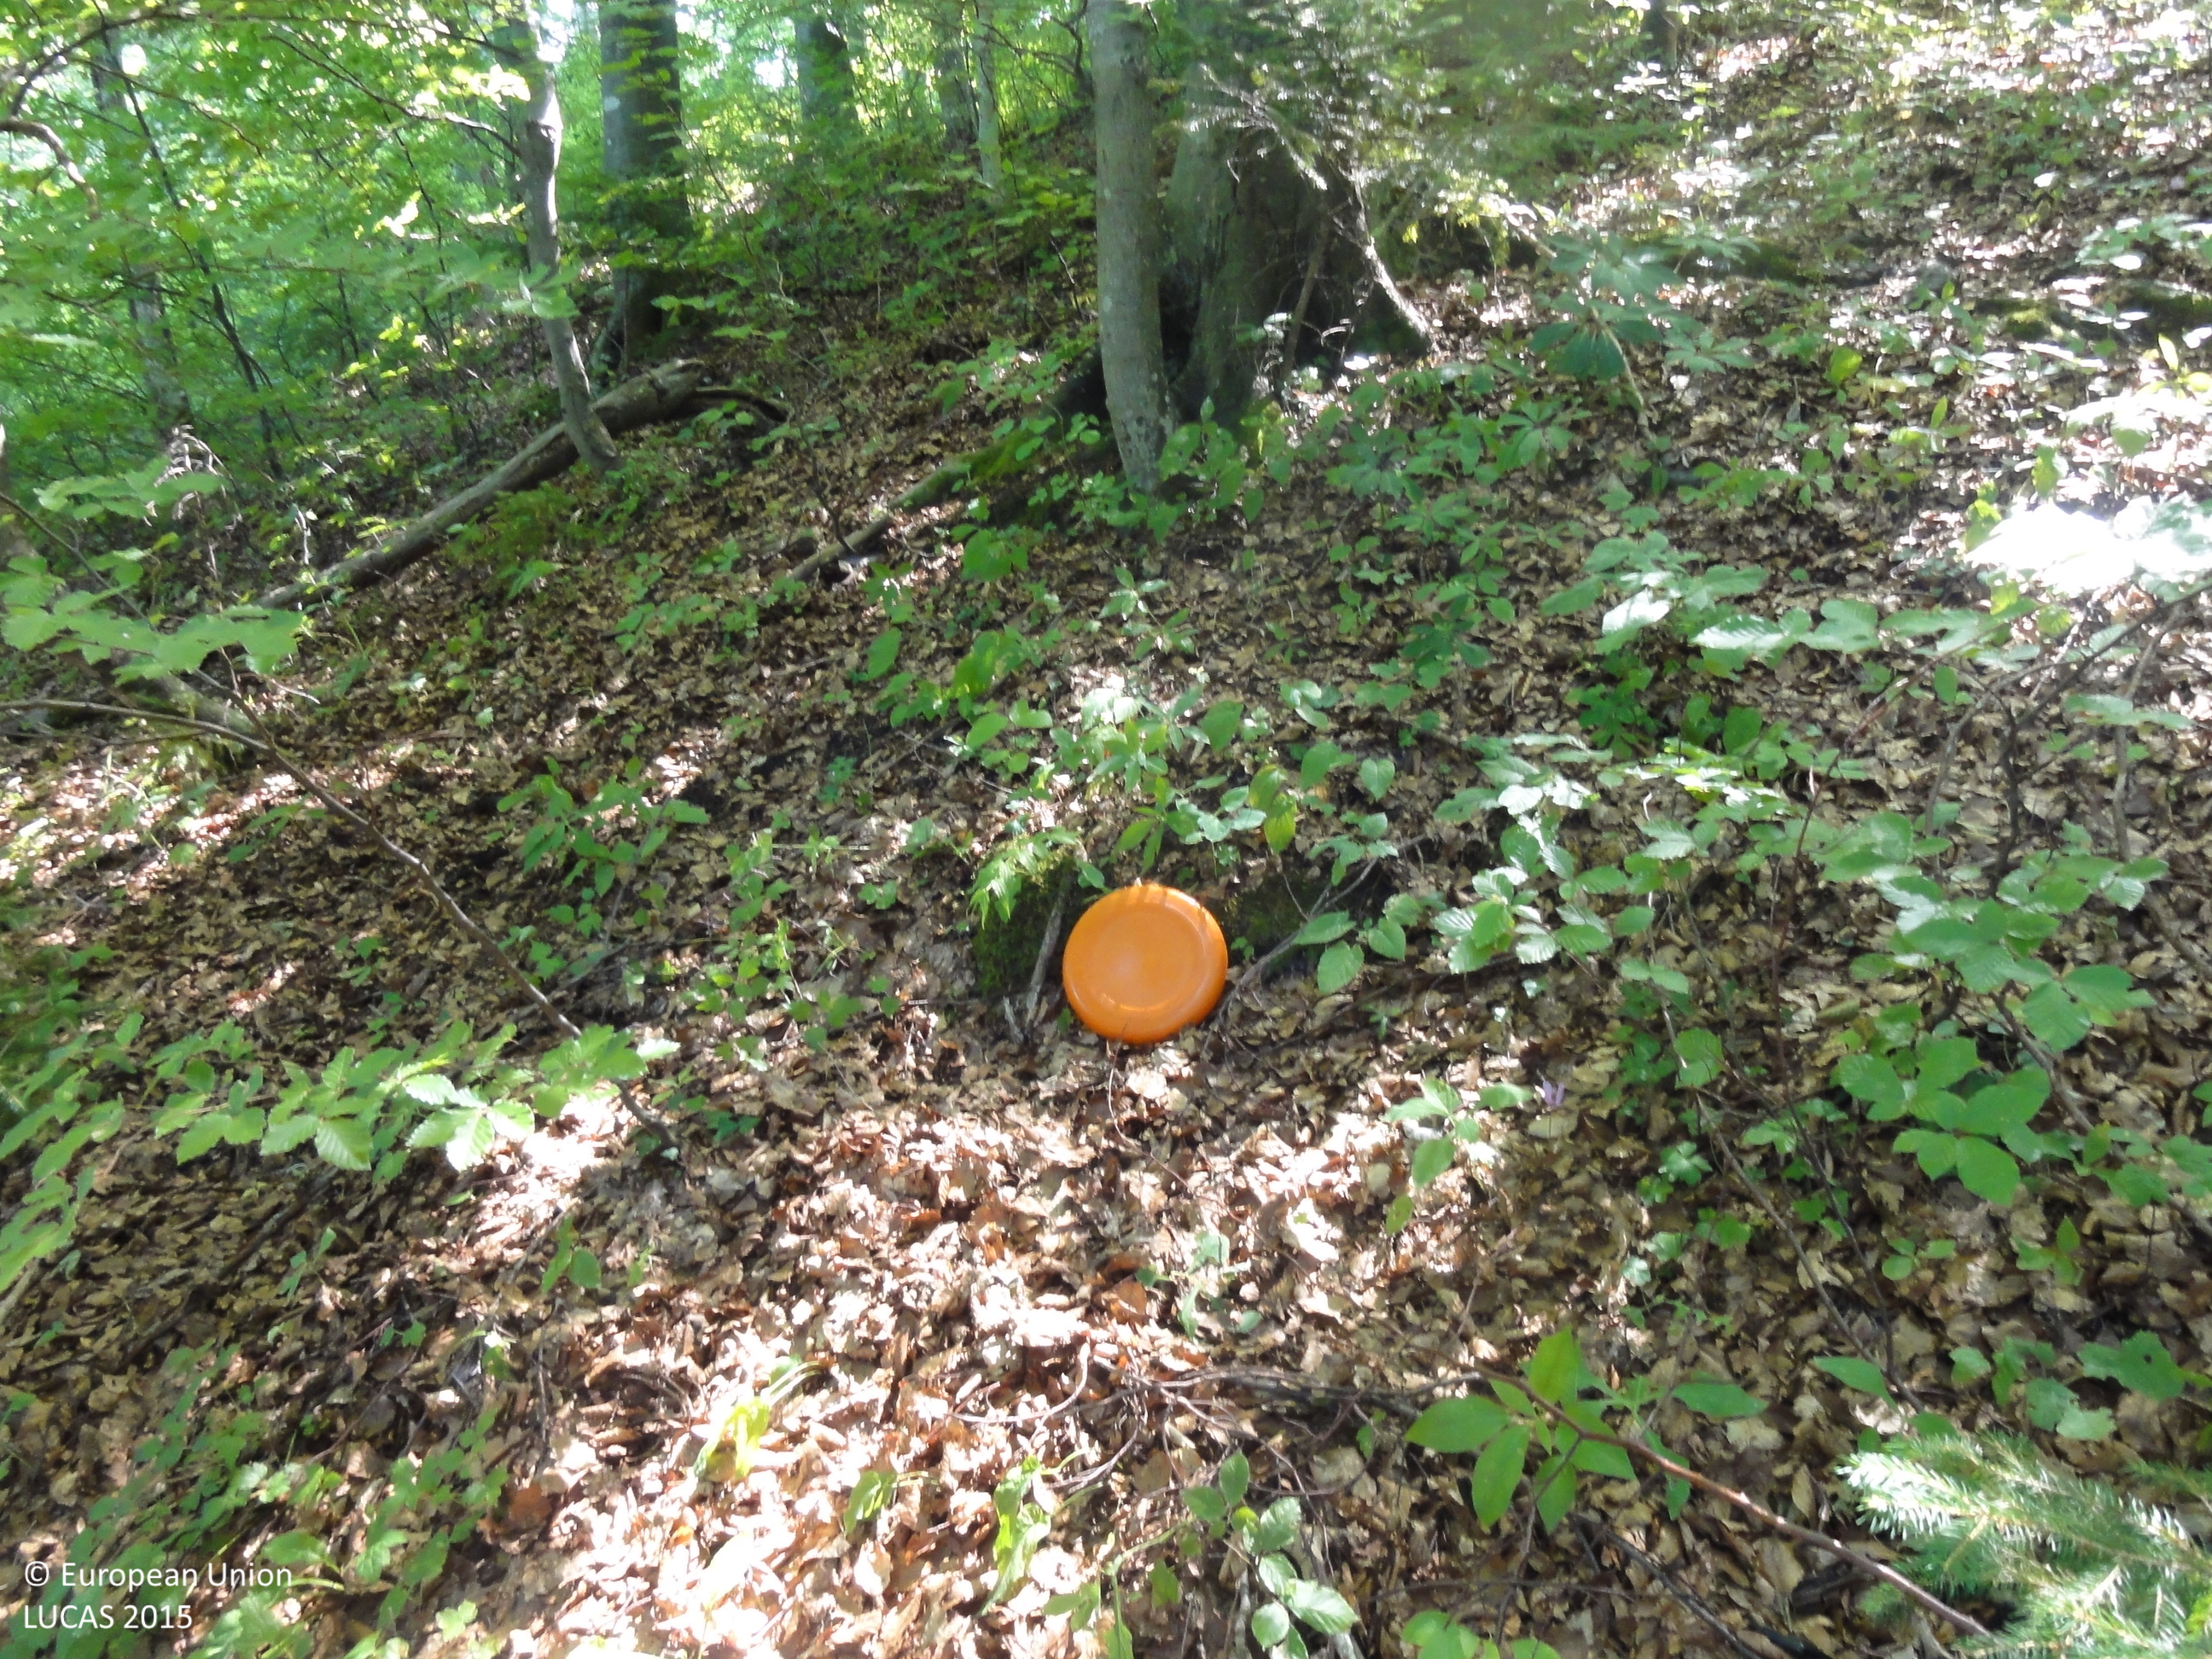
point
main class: Woodland
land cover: Broadleaved woodland
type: mountainous beech forest
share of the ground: > 75 %
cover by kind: broadleaved forest trees 100 %
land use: Forestry
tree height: > 5 m
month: August
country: SI
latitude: 46.0515
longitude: 15.0504
